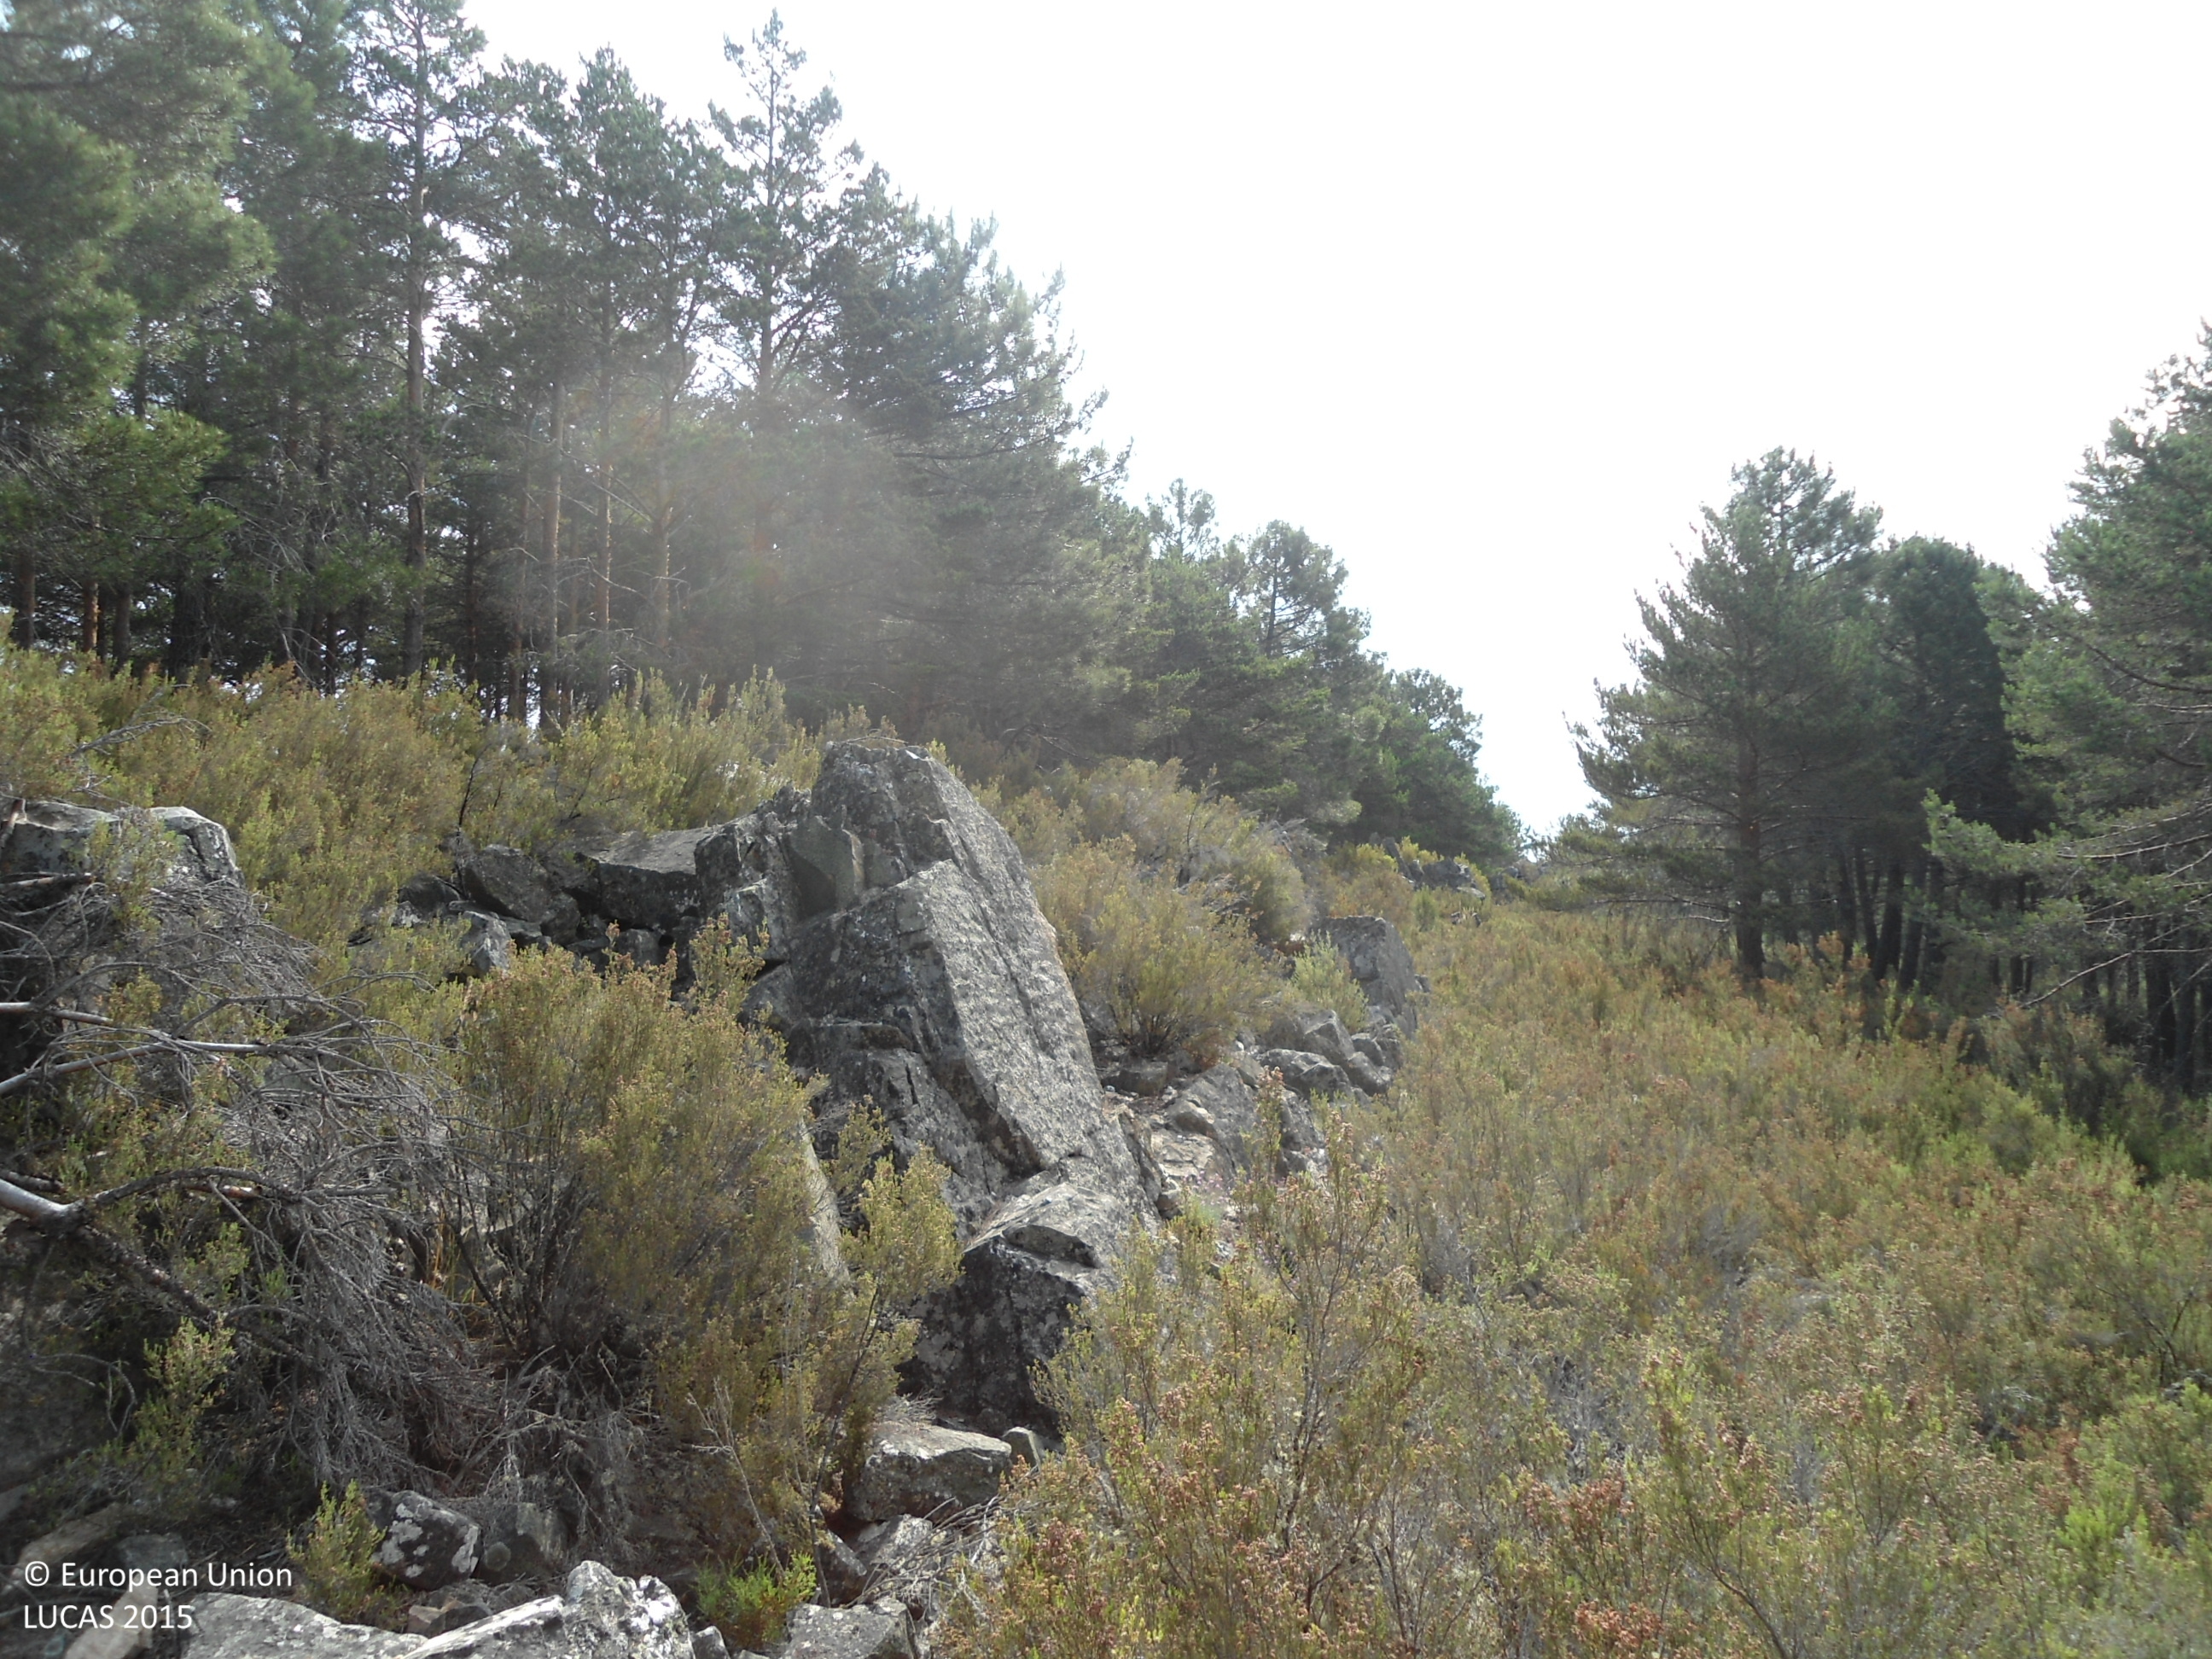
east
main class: Shrubland
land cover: Shrubland with sparse tree cover
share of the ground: > 75 %
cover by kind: shrubs 80 %, consolidated bare surface 15 %, coniferous forest trees 5 %
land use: Forestry
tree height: < 5 m
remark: Fire break
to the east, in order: Shrubland with sparse tree cover; Rock outcrops; Pine dominated coniferous woodland; Other bare soil; Tracks; Other bare soil; Fences; Pine dominated coniferous woodland
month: June
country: ES
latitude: 41.9102
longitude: -6.1963
